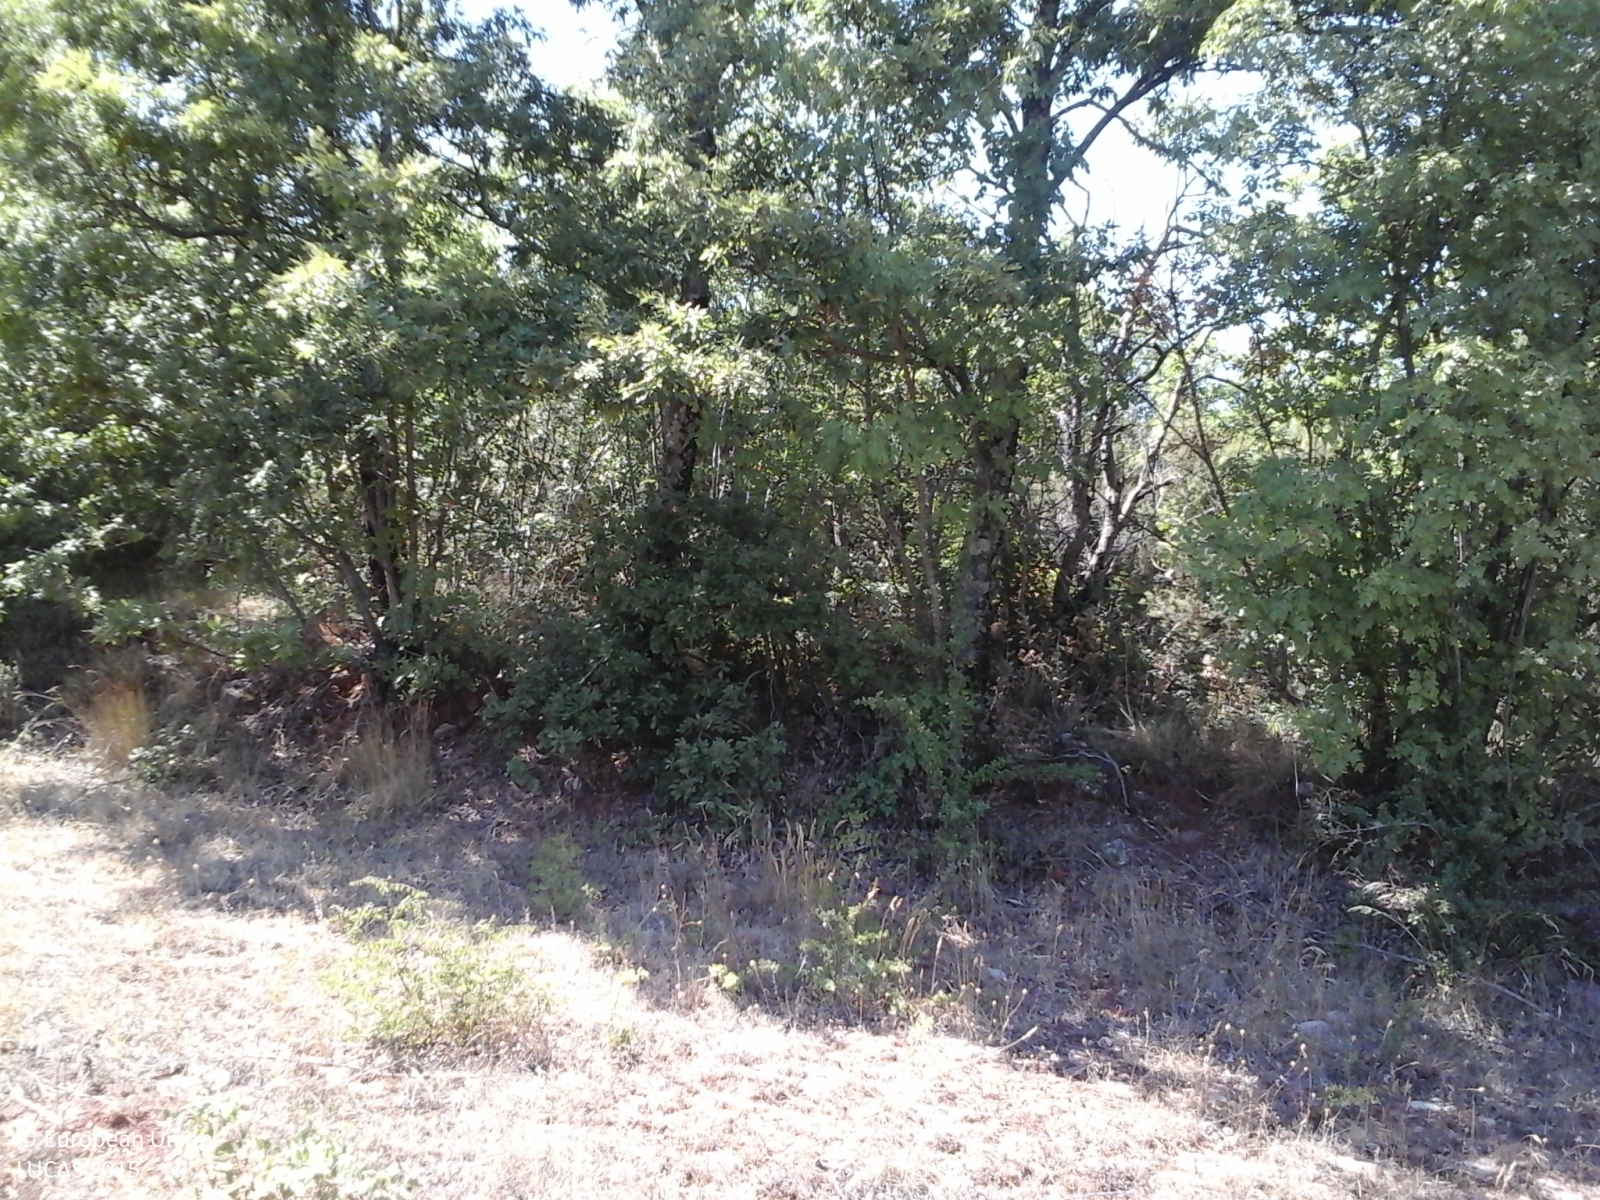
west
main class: Woodland
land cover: Broadleaved woodland
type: thermophilous deciduous forest
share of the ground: > 75 %
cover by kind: broadleaved forest trees 75 %, shrubs 20 %, herbaceous plants 5 %
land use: Forestry
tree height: > 5 m
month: August
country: IT
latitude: 42.6238
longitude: 11.5676
